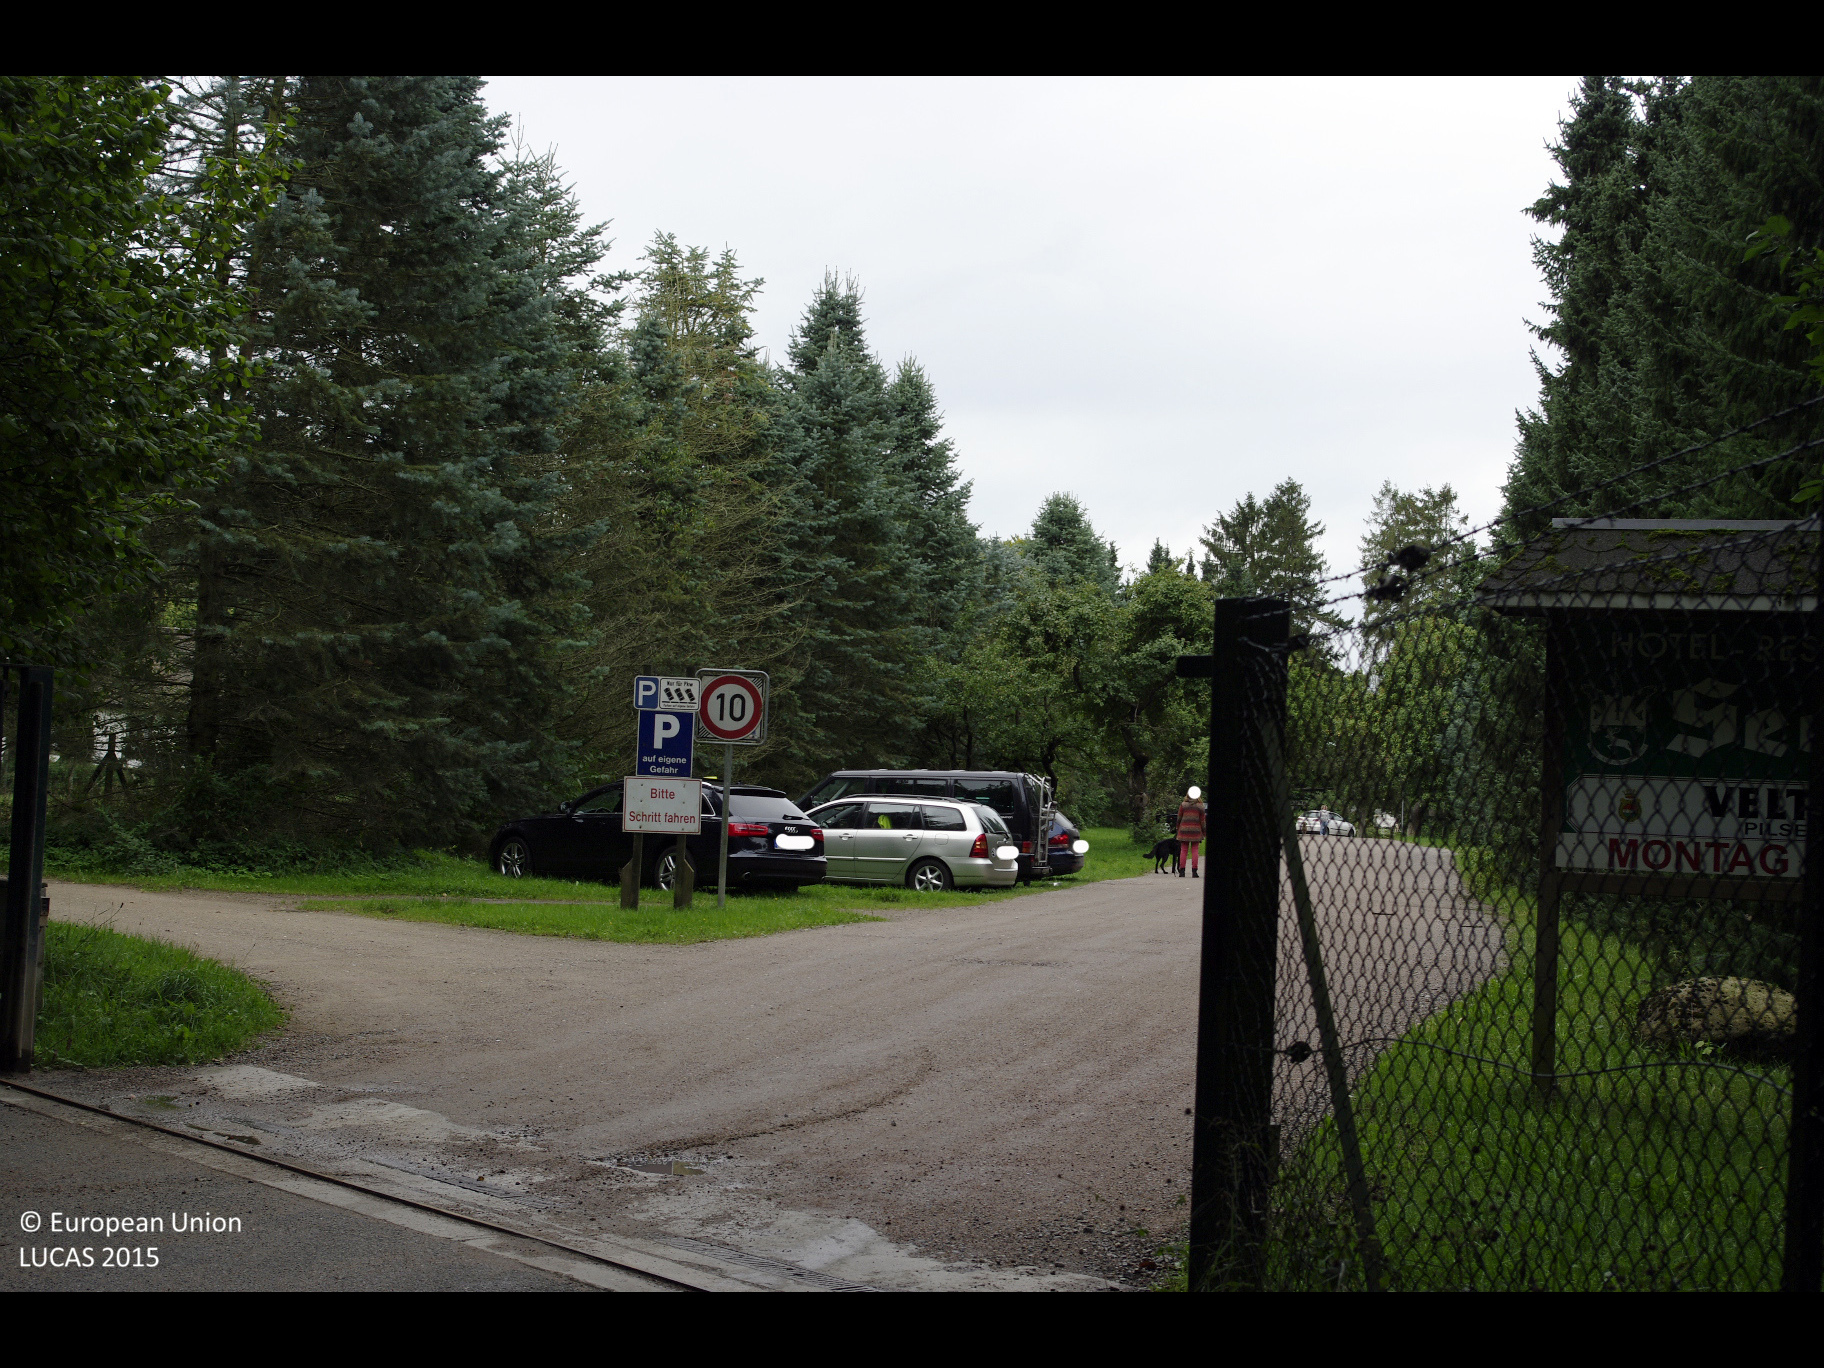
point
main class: Cropland
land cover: Apple fruit
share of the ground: 25 - 50 %
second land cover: Grassland without tree/shrub cover
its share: > 75 %
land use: Agriculture (excluding fallow land and kitchen gardens)
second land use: Amenities, museums, leisure
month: September
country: DE
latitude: 53.6529
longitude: 10.3780
